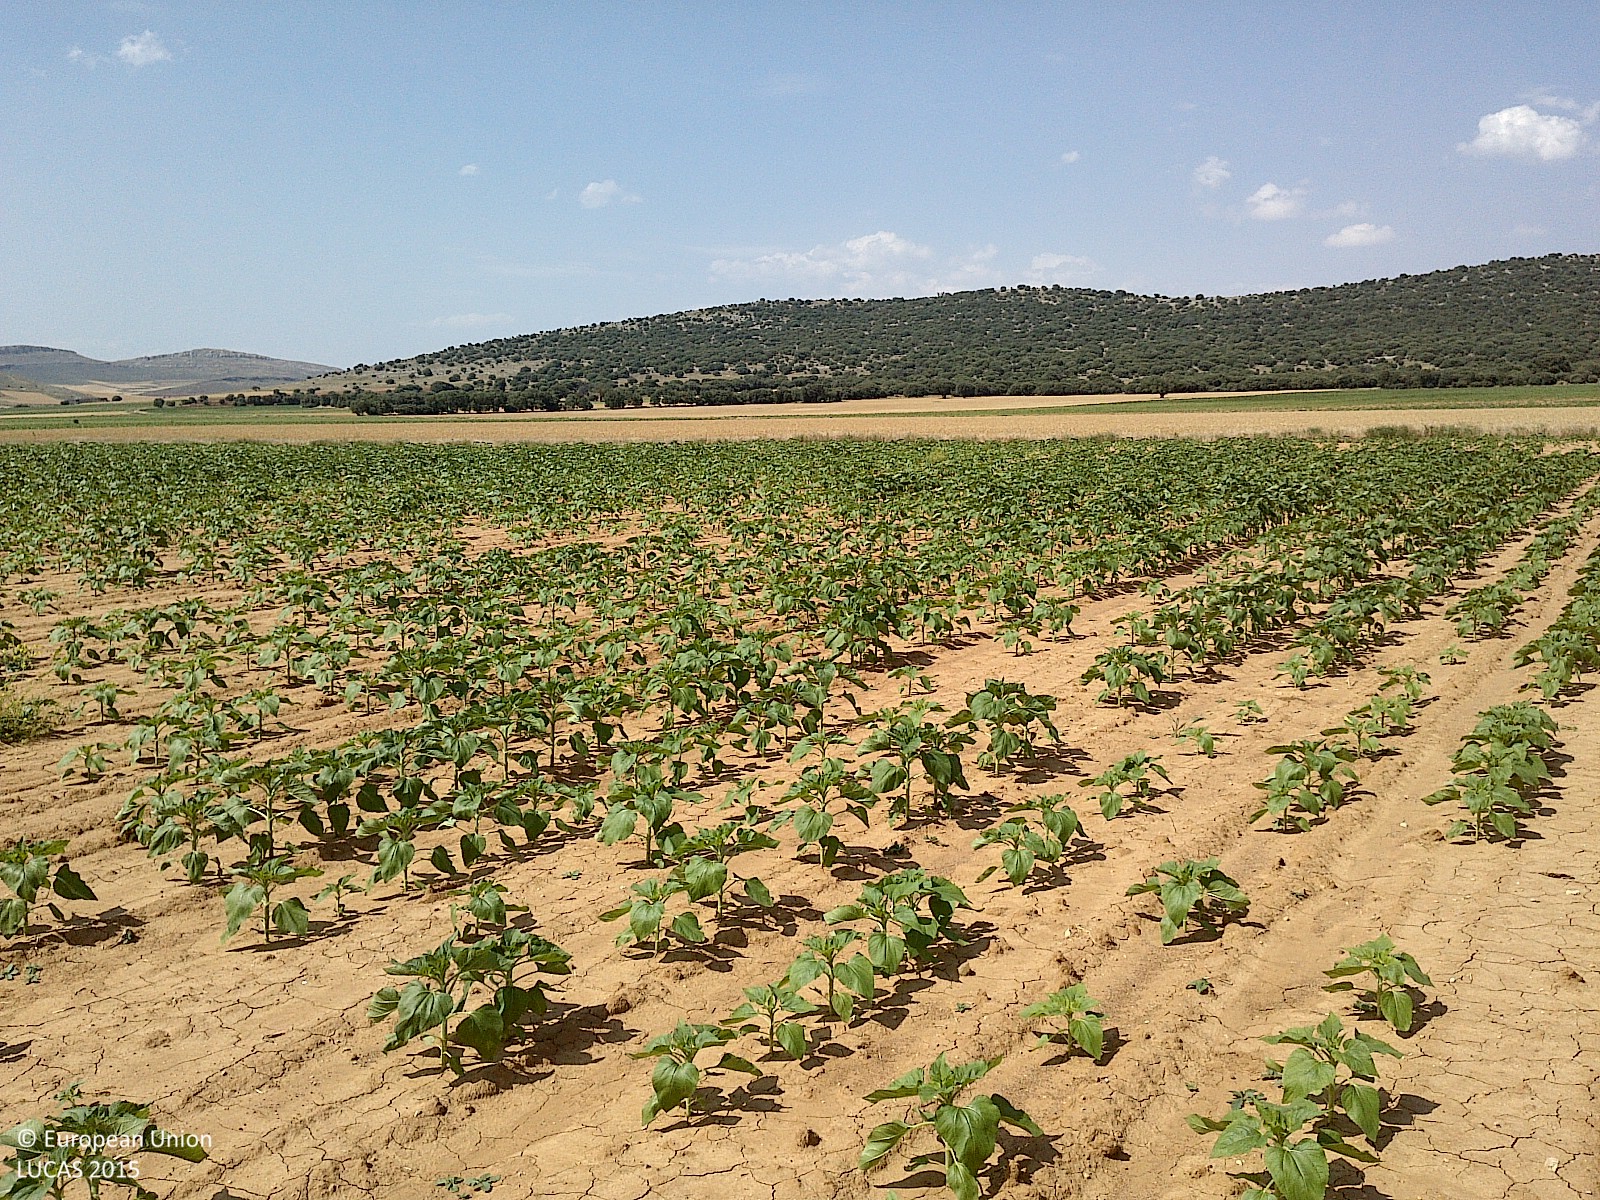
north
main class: Cropland
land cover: Sunflower
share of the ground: < 10 %
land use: Agriculture (excluding fallow land and kitchen gardens)
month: July
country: ES
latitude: 41.6135
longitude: -2.1170
